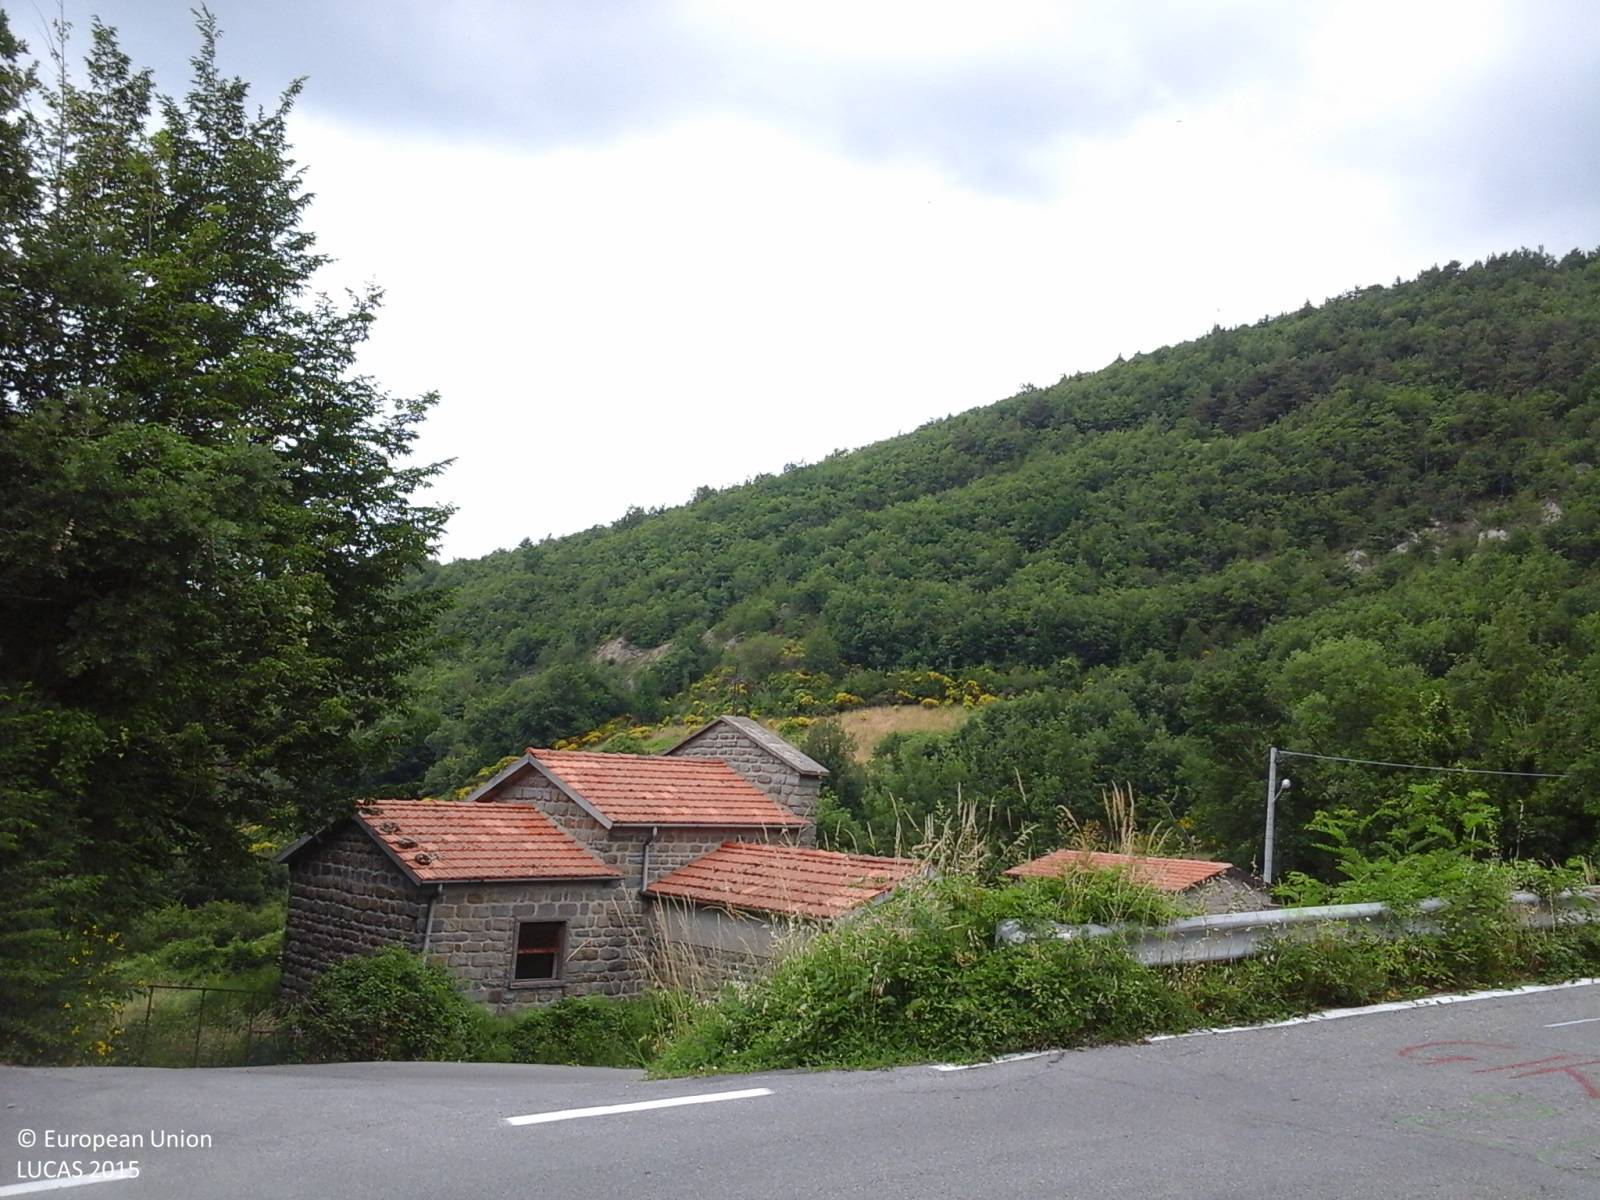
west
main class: Woodland
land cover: Broadleaved woodland
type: acidophilous oak and oak-birch forest
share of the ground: > 75 %
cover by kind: broadleaved forest trees 75 %, coniferous forest trees 25 %
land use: Semi-natural and natural areas not in use
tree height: > 5 m
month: June
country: IT
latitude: 44.2060
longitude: 10.2122
